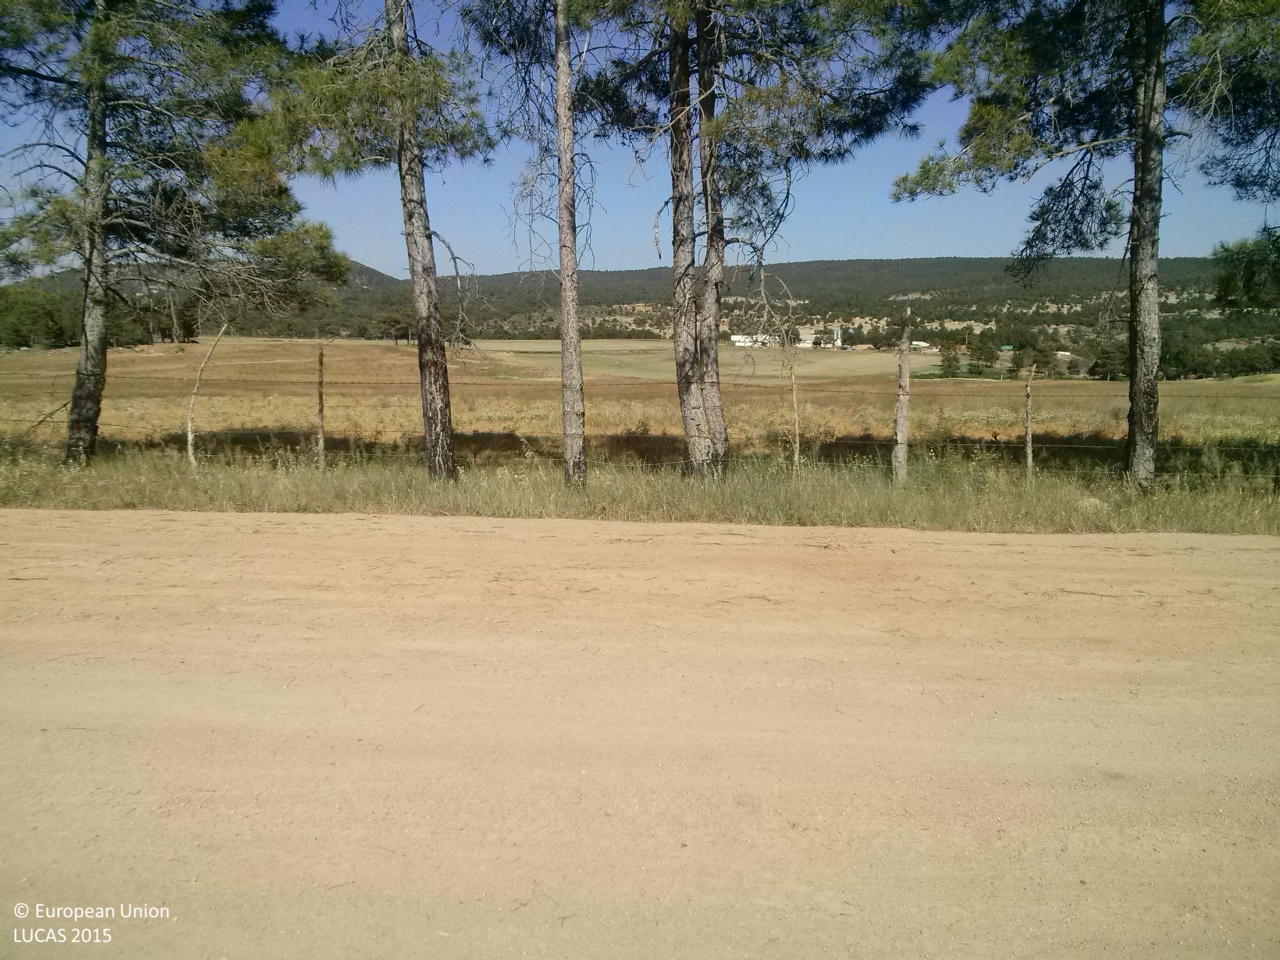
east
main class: Grassland
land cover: Grassland with sparse tree/shrub cover
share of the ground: > 75 %
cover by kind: herbaceous plants 90 %, coniferous forest trees 5 %, shrubs 5 %
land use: Agriculture (excluding fallow land and kitchen gardens)
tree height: > 5 m
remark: Burnt area
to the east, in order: Grassland with sparse tree/shrub cover; Fences; Grass margins; Tracks; Grass margins; Abandoned hedges; Fences; Grass margins; Dry pulses; Arable land (only in case pi)
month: June
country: ES
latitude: 39.8690
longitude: -1.9011
